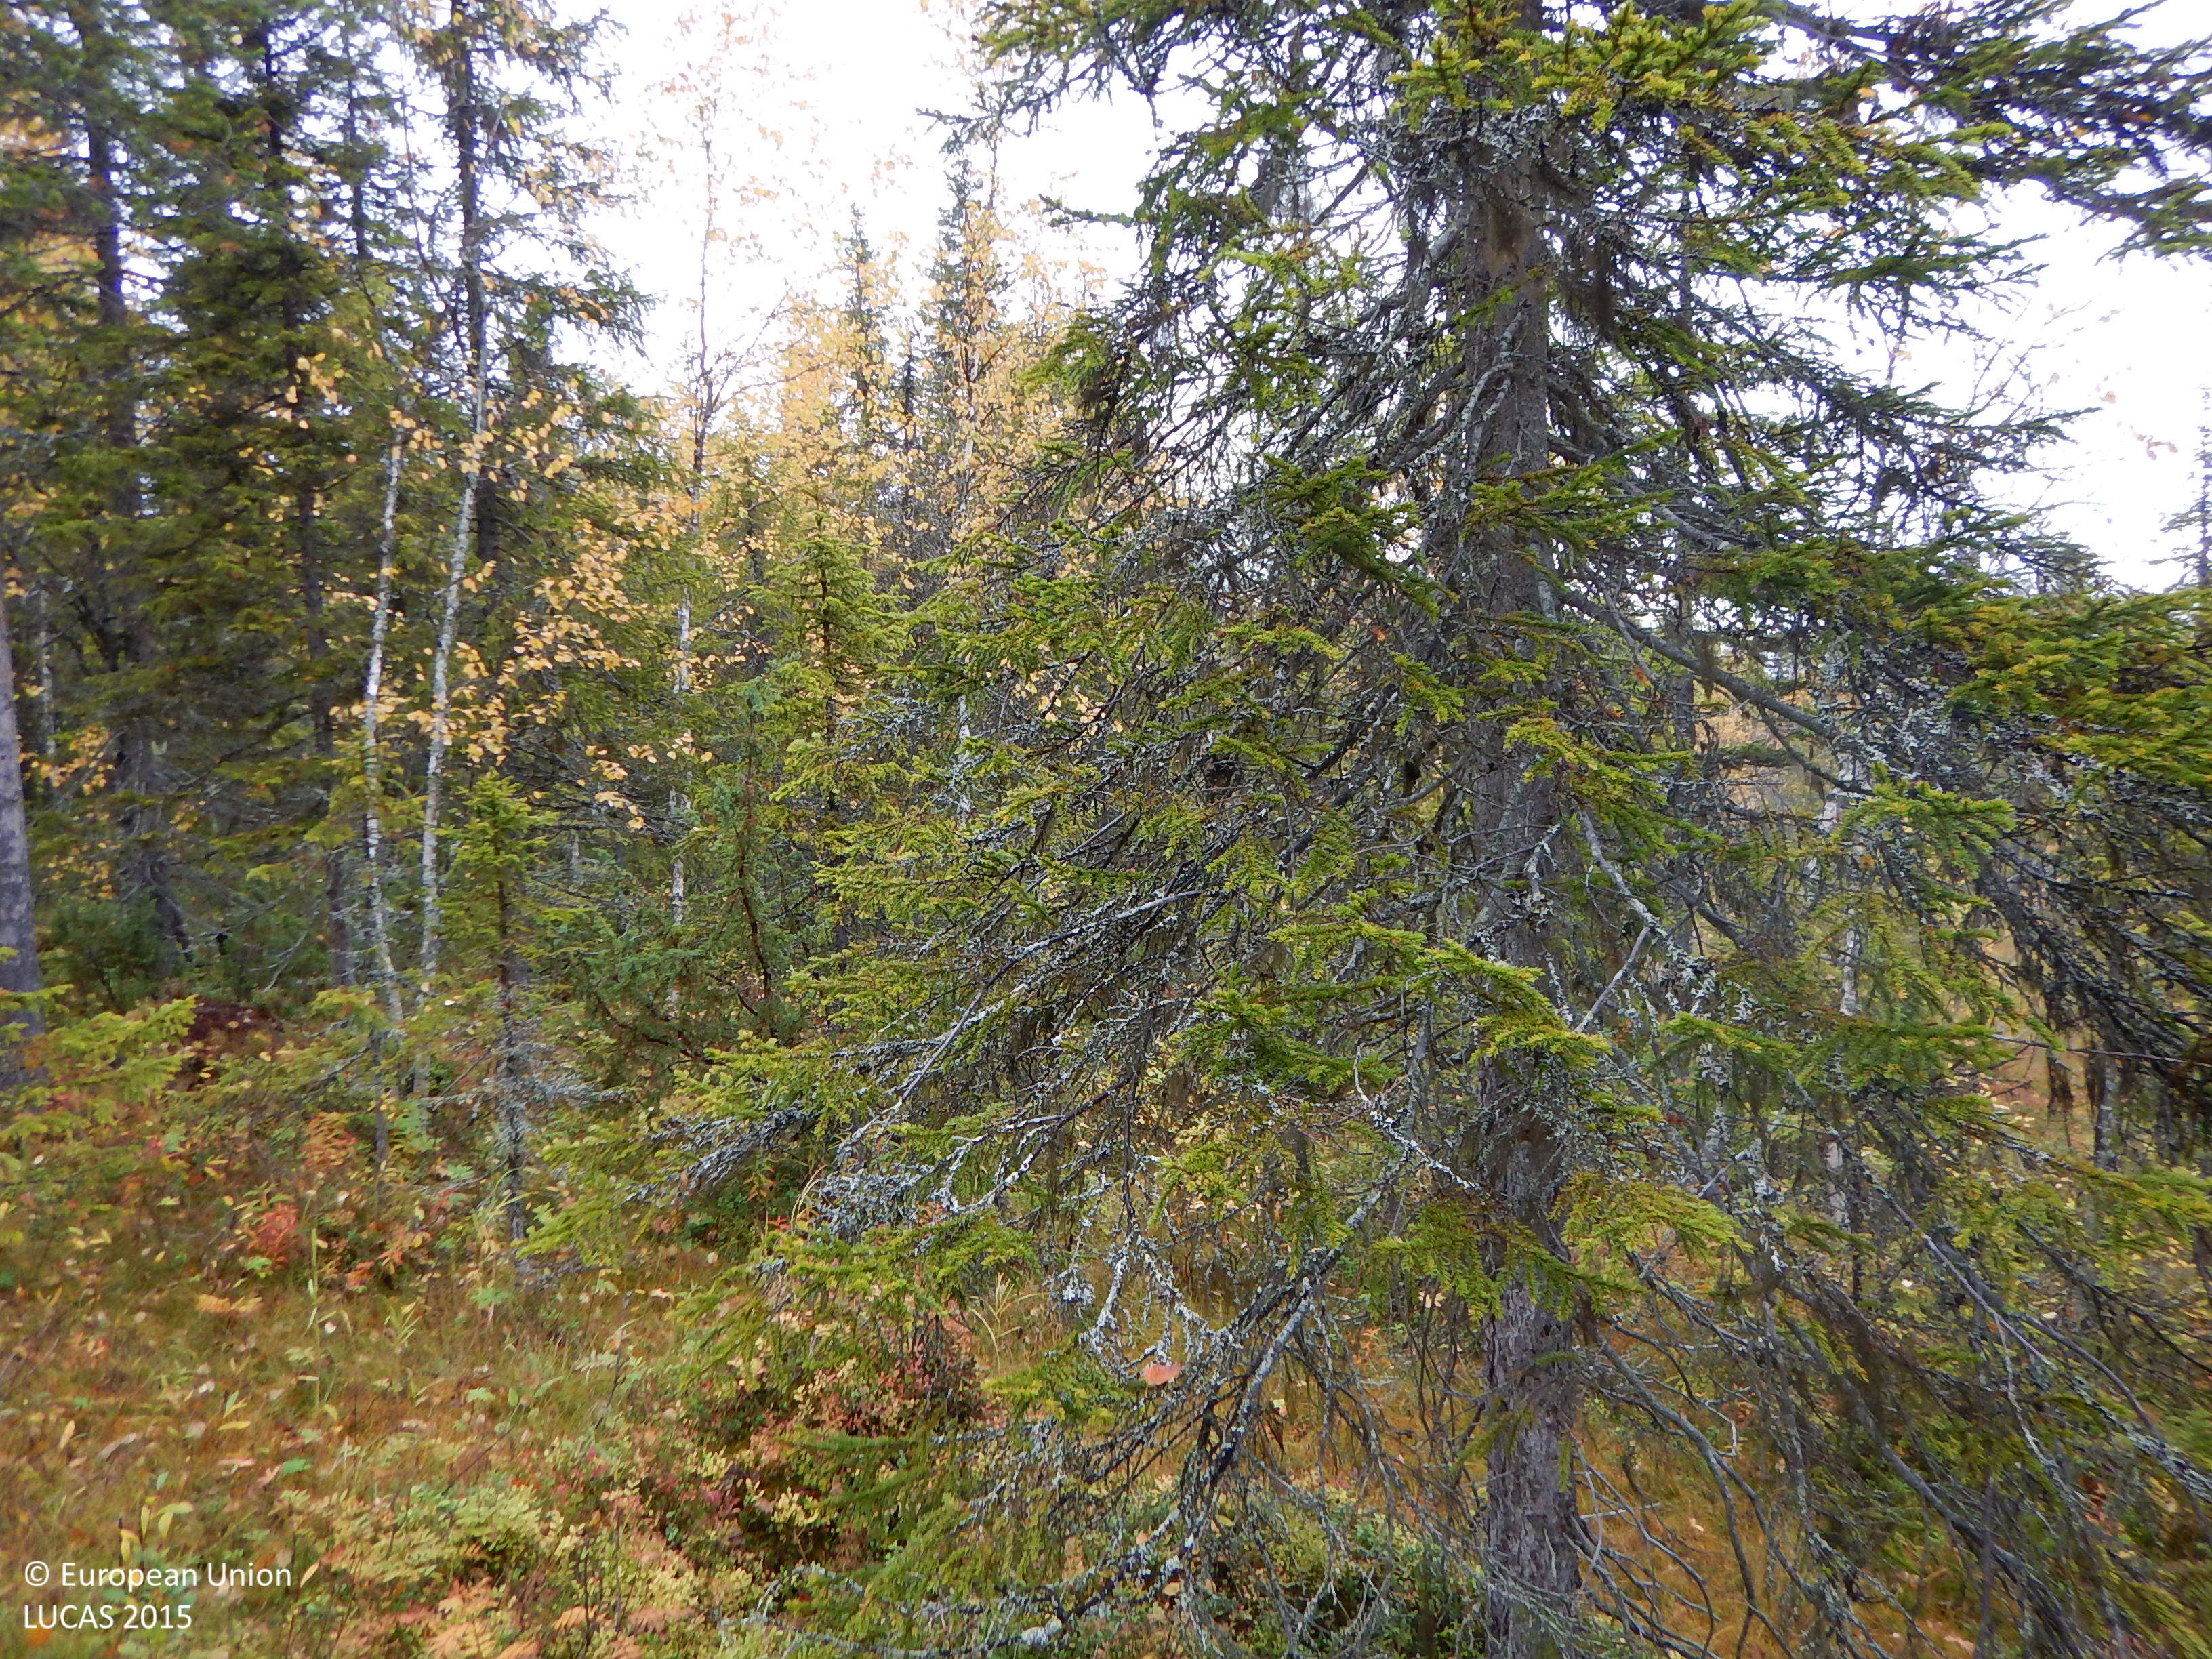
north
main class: Woodland
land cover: Spruce dominated mixed woodland
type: mire and swamp forests
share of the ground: 25 - 50 %
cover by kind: coniferous forest trees 30 %, lichens and mosses 30 %, broadleaved forest trees 15 %, shrubs 15 %, herbaceous plants 10 %
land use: Forestry
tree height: > 5 m
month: September
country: SE
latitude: 65.1872
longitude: 19.5116
